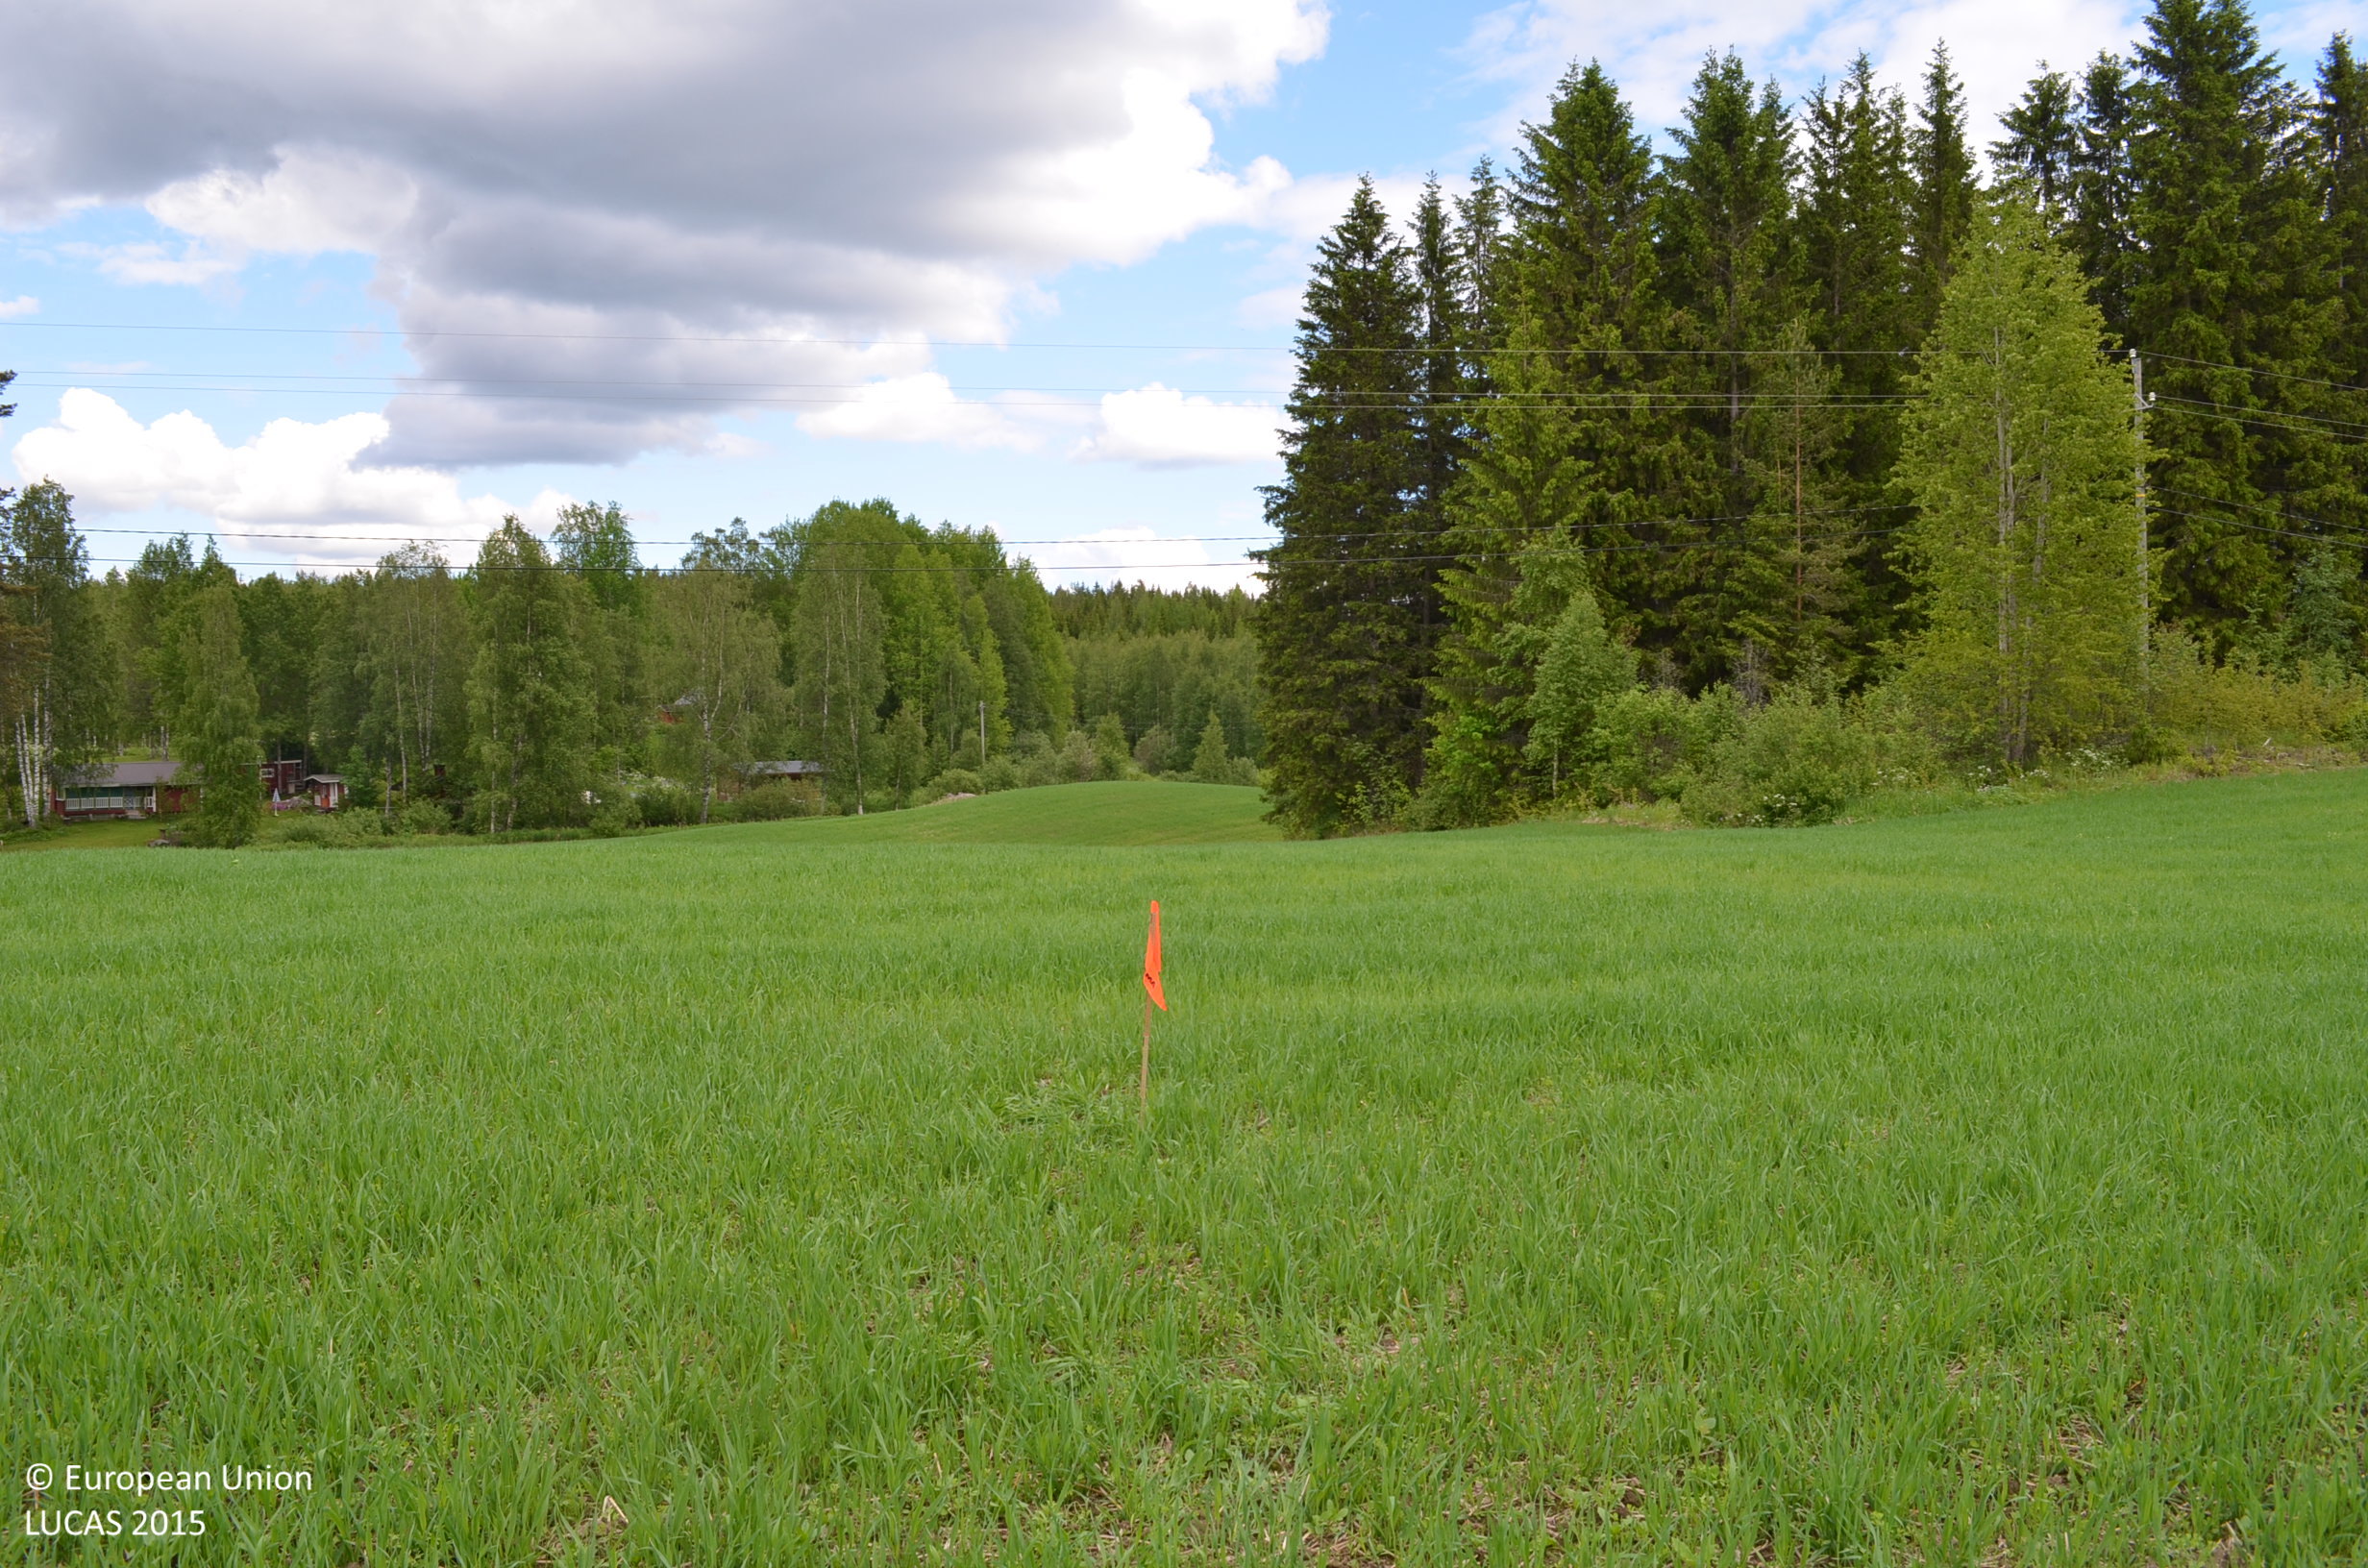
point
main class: Cropland
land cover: Oats
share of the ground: > 75 %
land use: Agriculture (excluding fallow land and kitchen gardens)
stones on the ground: 10 - 25 %
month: June
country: FI
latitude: 61.8314
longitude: 23.3474
